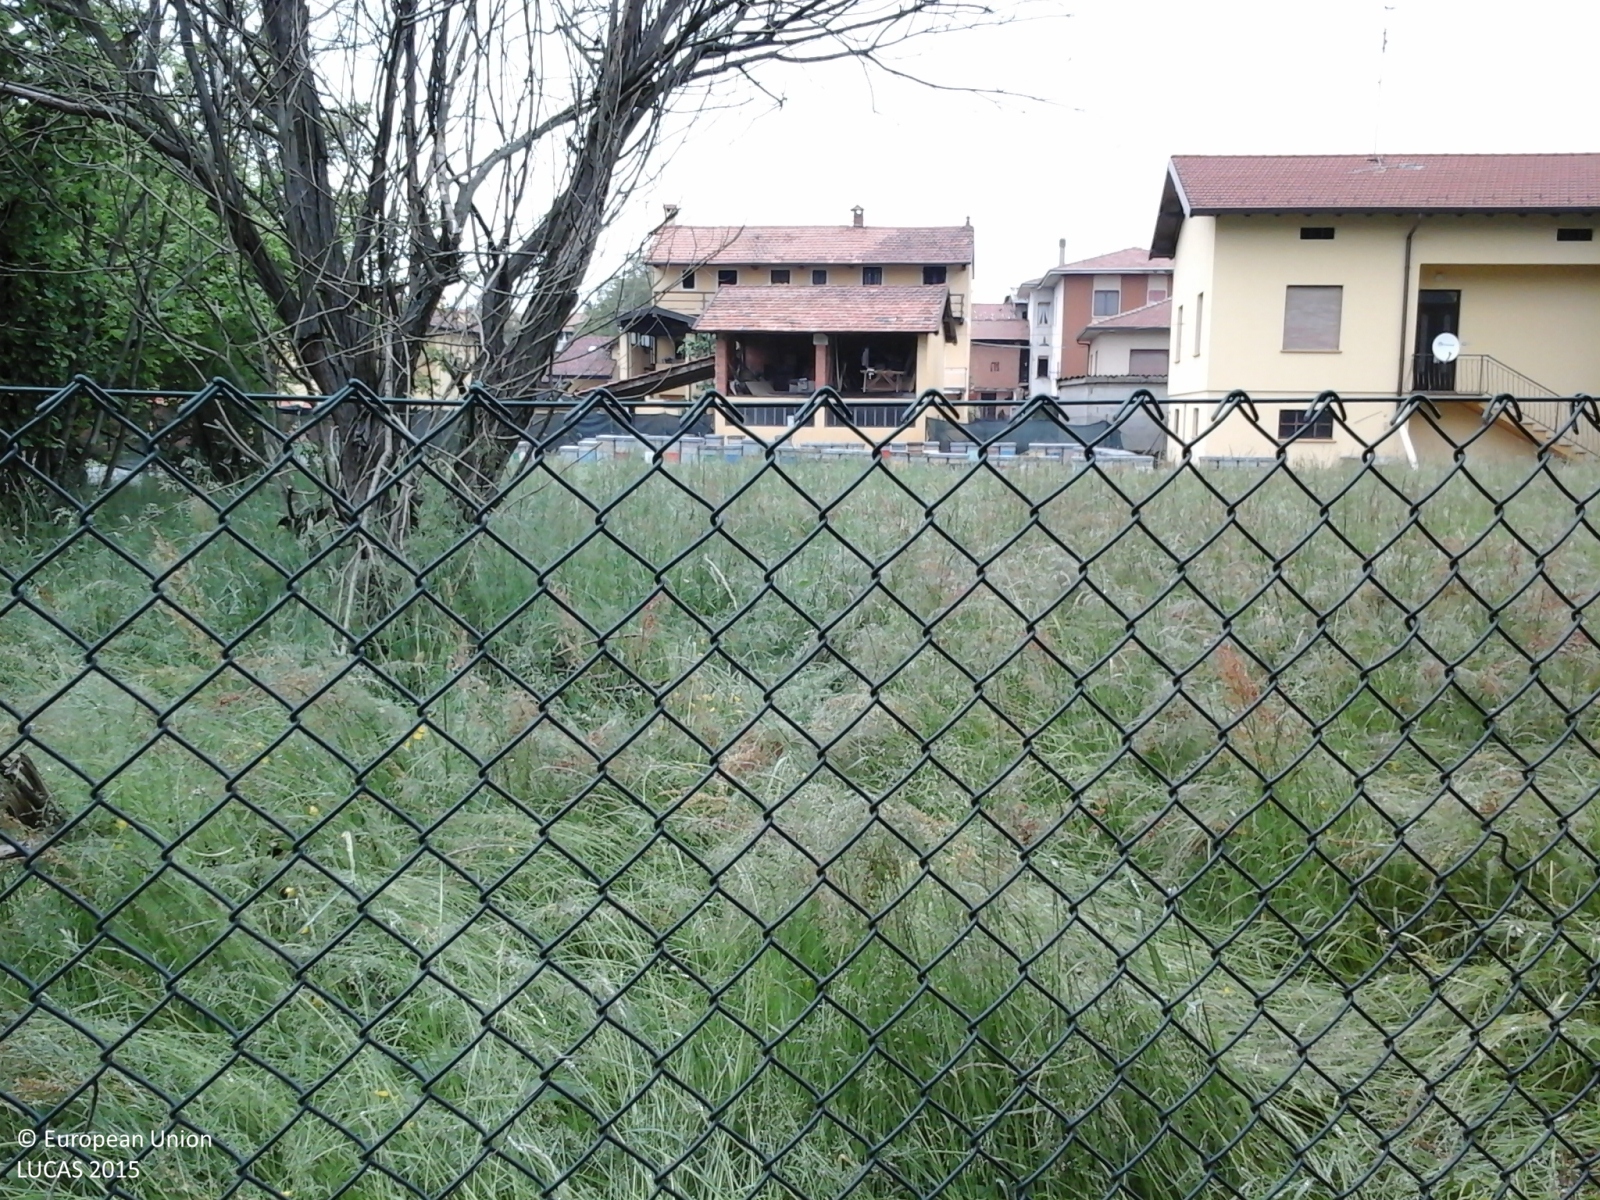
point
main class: Grassland
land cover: Grassland with sparse tree/shrub cover
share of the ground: > 75 %
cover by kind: herbaceous plants 95 %, broadleaved forest trees 5 %
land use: Residential
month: May
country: IT
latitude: 45.6574
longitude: 8.6034
